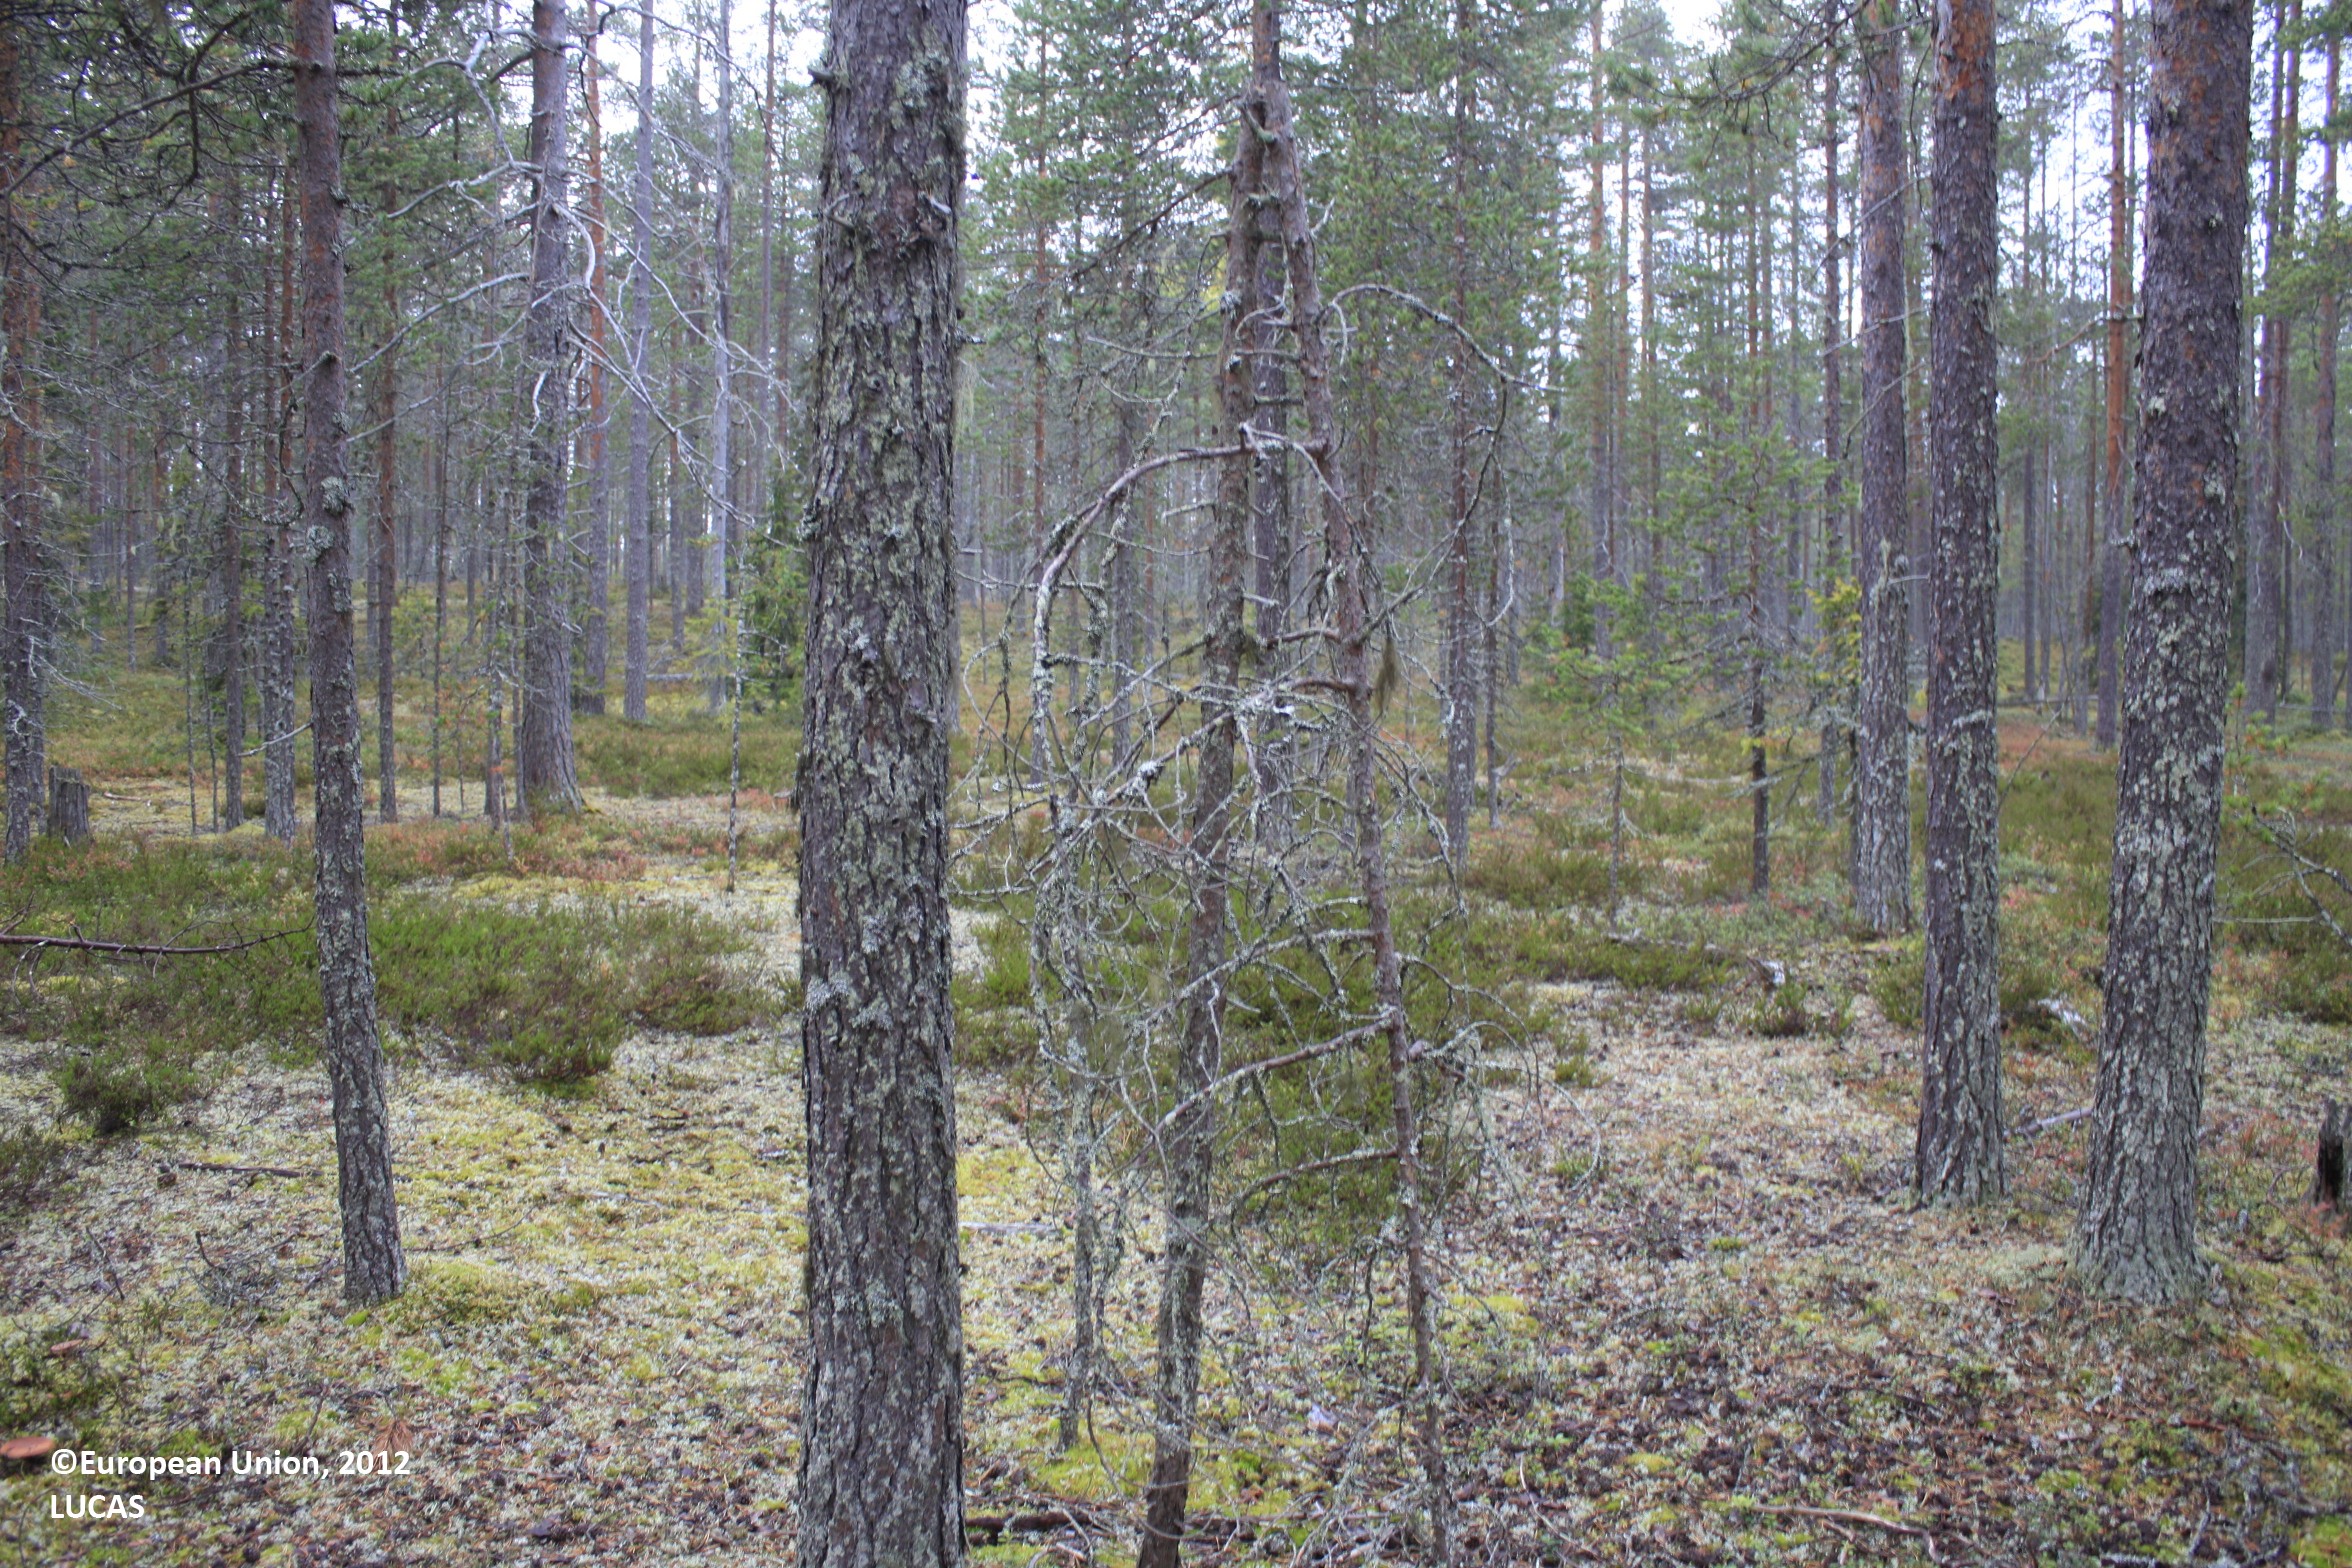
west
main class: Woodland
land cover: Pine dominated coniferous woodland
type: boreal forest
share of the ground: 50 - 75 %
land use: Forestry
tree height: > 5 m
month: September
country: FI
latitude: 65.5409
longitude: 27.1087
